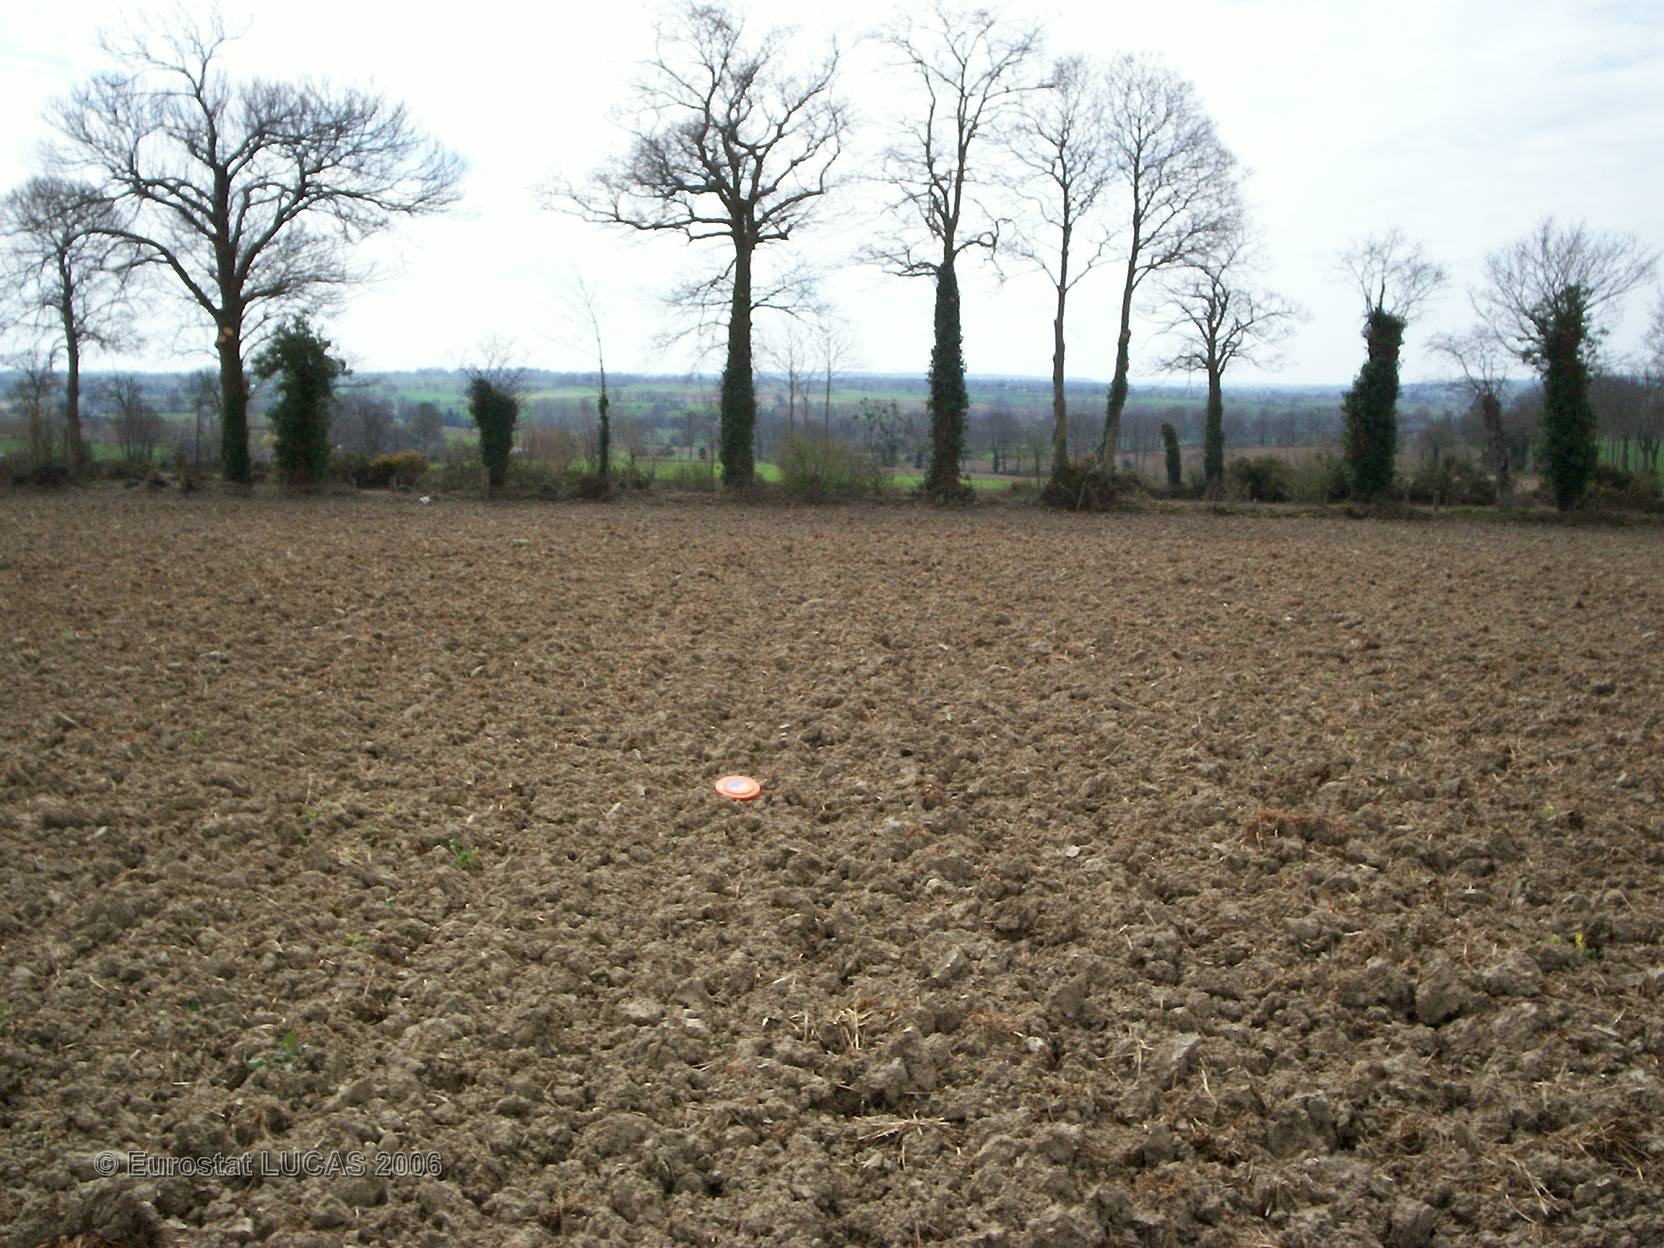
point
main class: Cropland
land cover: Maize
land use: Agriculture (excluding fallow land and kitchen gardens)
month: April
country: FR
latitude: 48.5171
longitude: -1.4319
